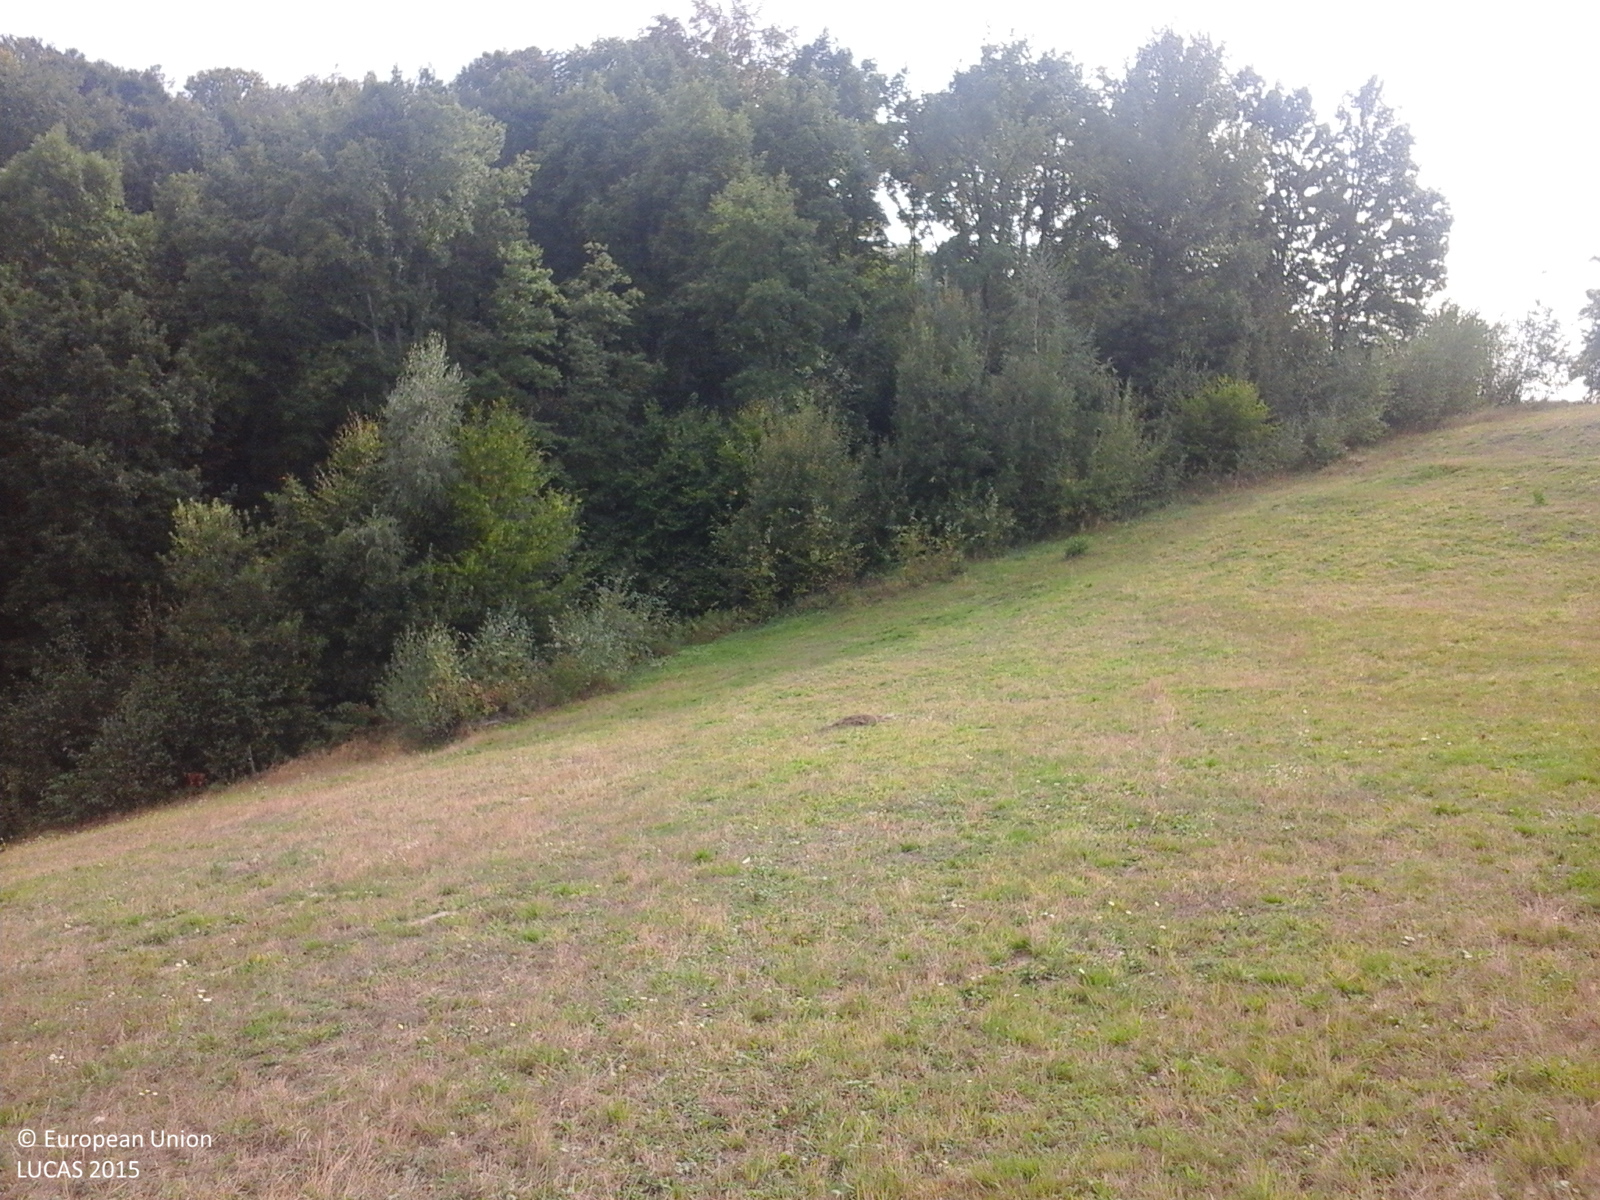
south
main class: Grassland
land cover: Grassland without tree/shrub cover
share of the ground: > 75 %
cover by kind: herbaceous plants 100 %
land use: Agriculture (excluding fallow land and kitchen gardens)
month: September
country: RO
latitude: 47.4143
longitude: 24.0126
